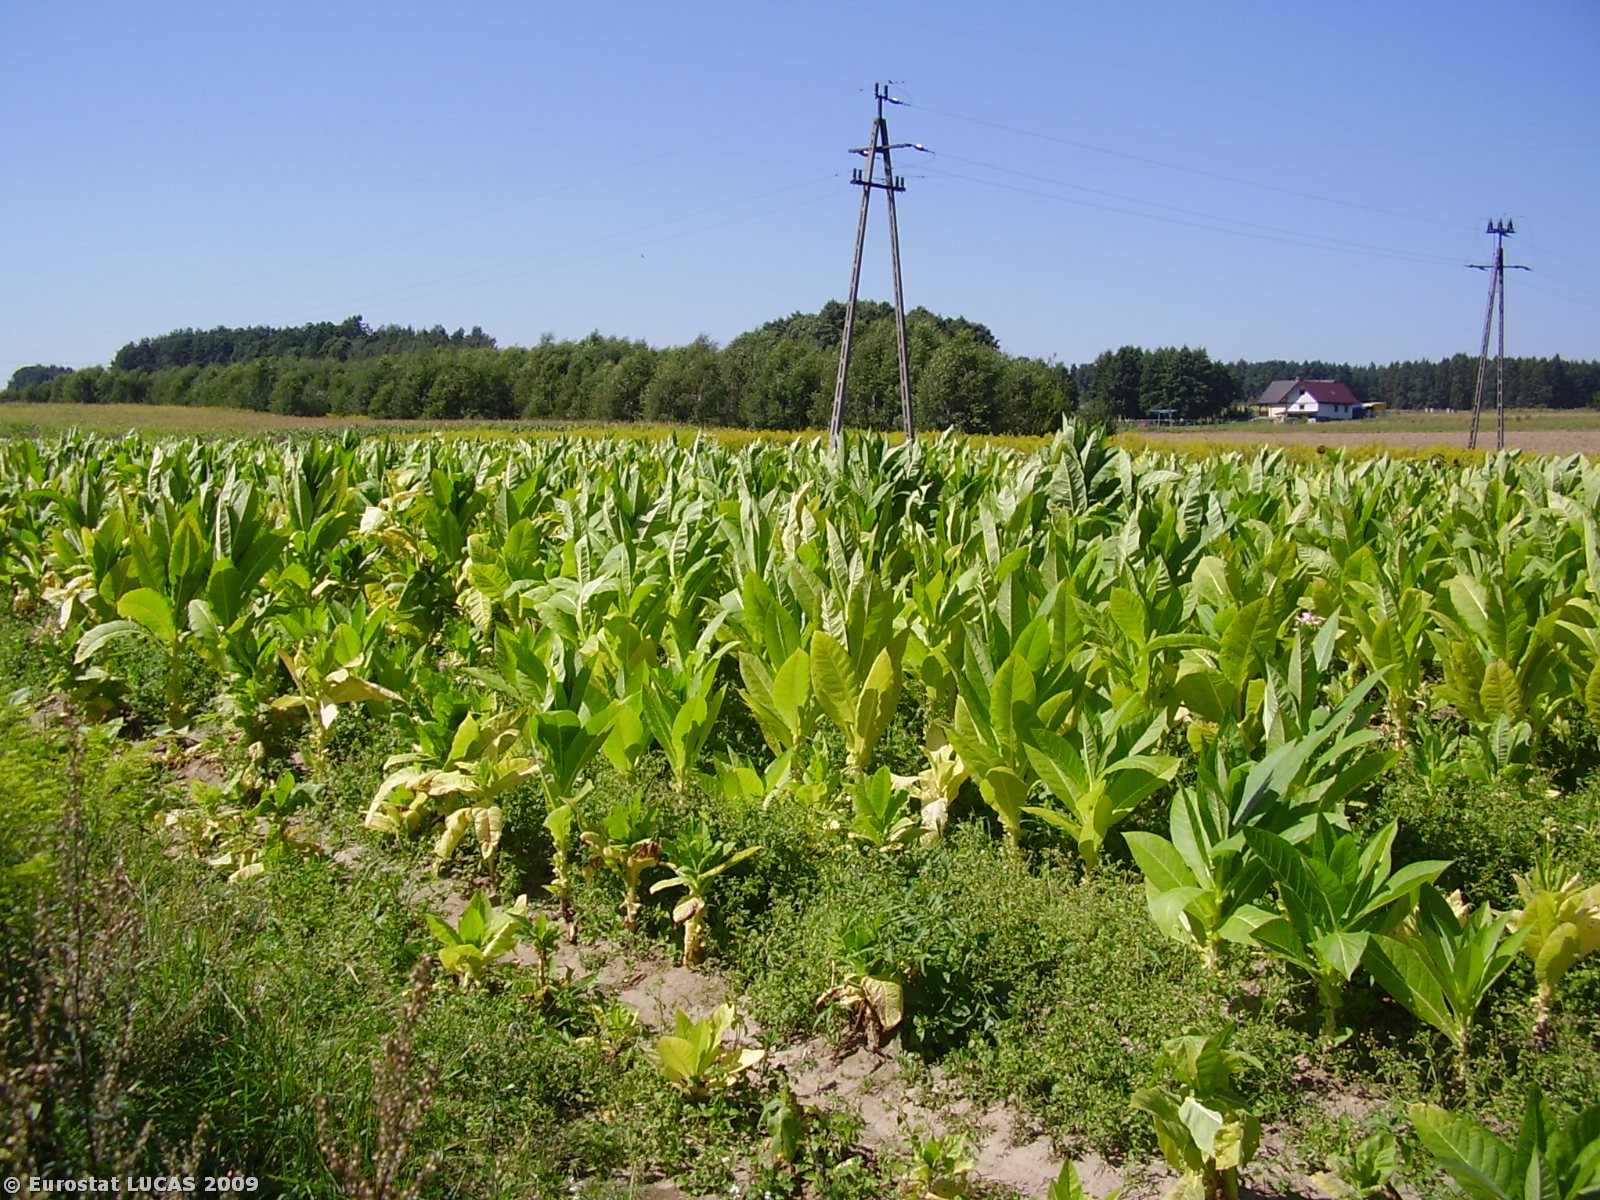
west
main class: Grassland
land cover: Spontaneously vegetated surfaces
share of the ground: > 75 %
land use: Unused
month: August
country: PL
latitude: 51.3034
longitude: 17.3127
